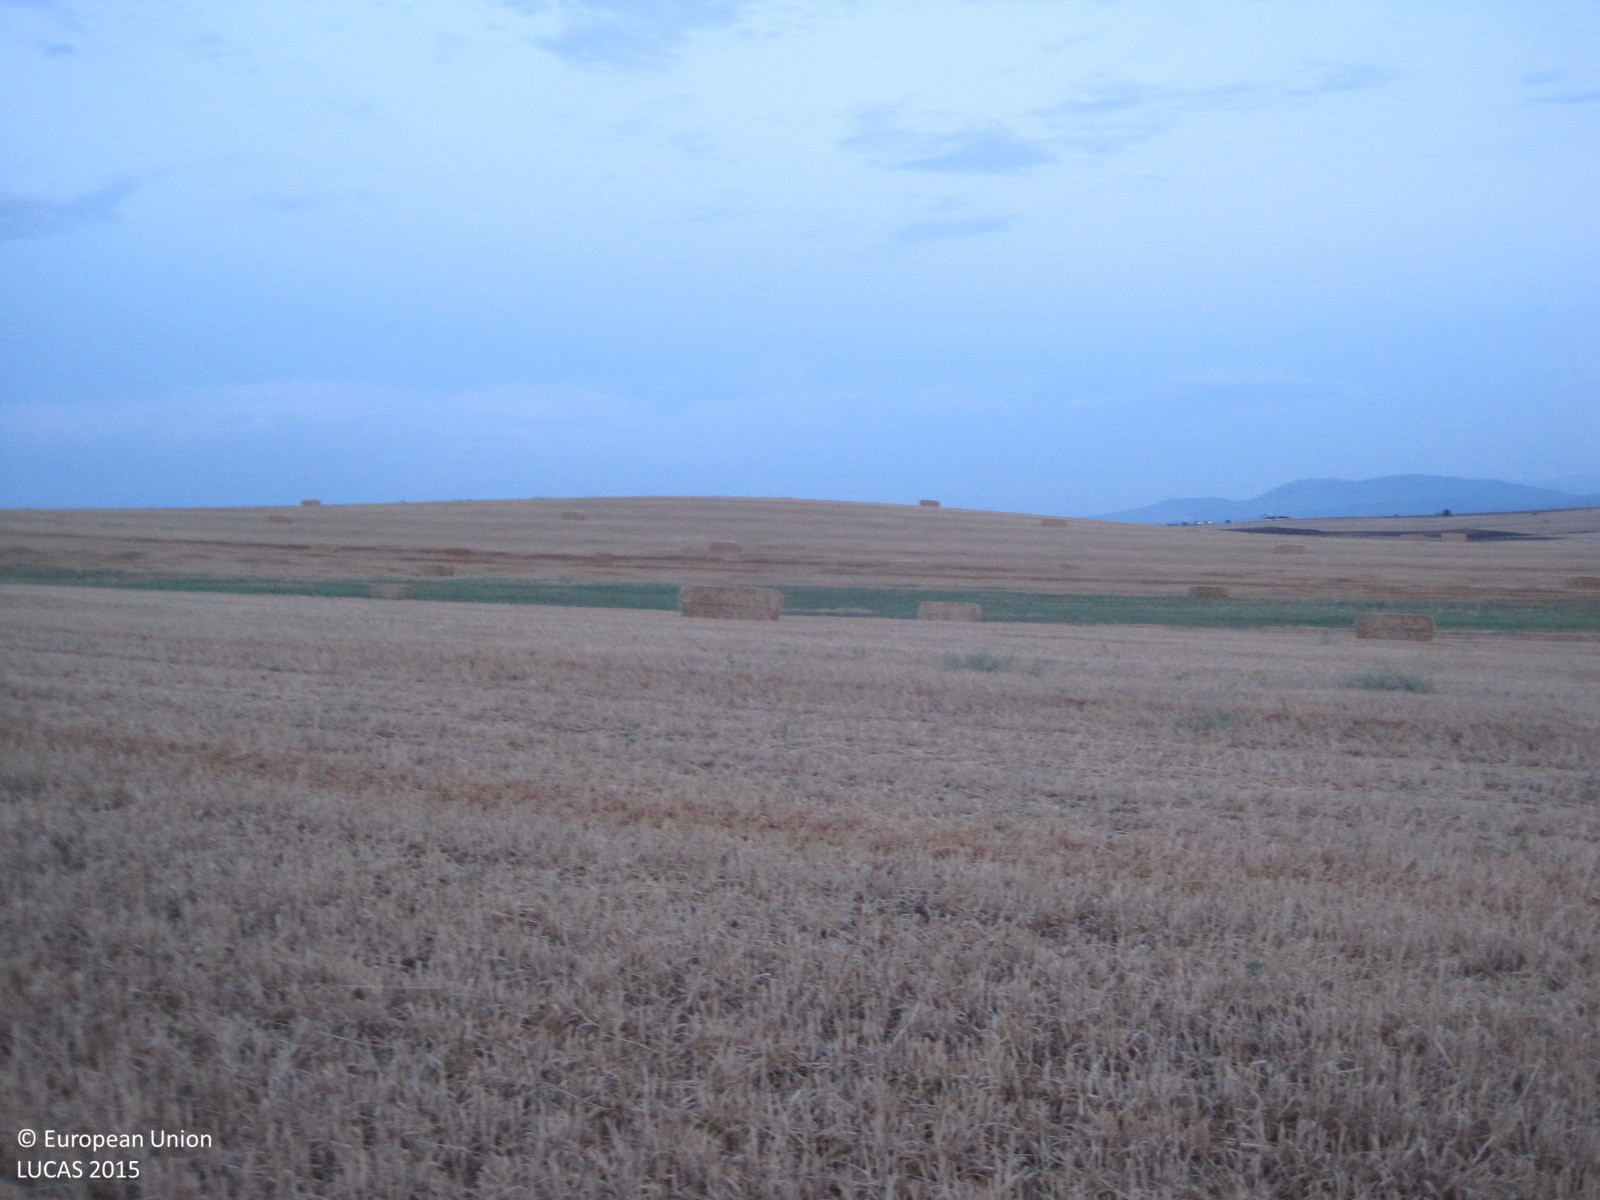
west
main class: Cropland
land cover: Oats
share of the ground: < 10 %
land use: Agriculture (excluding fallow land and kitchen gardens)
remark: Harvested field
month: July
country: ES
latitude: 40.0707
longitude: -4.3349
